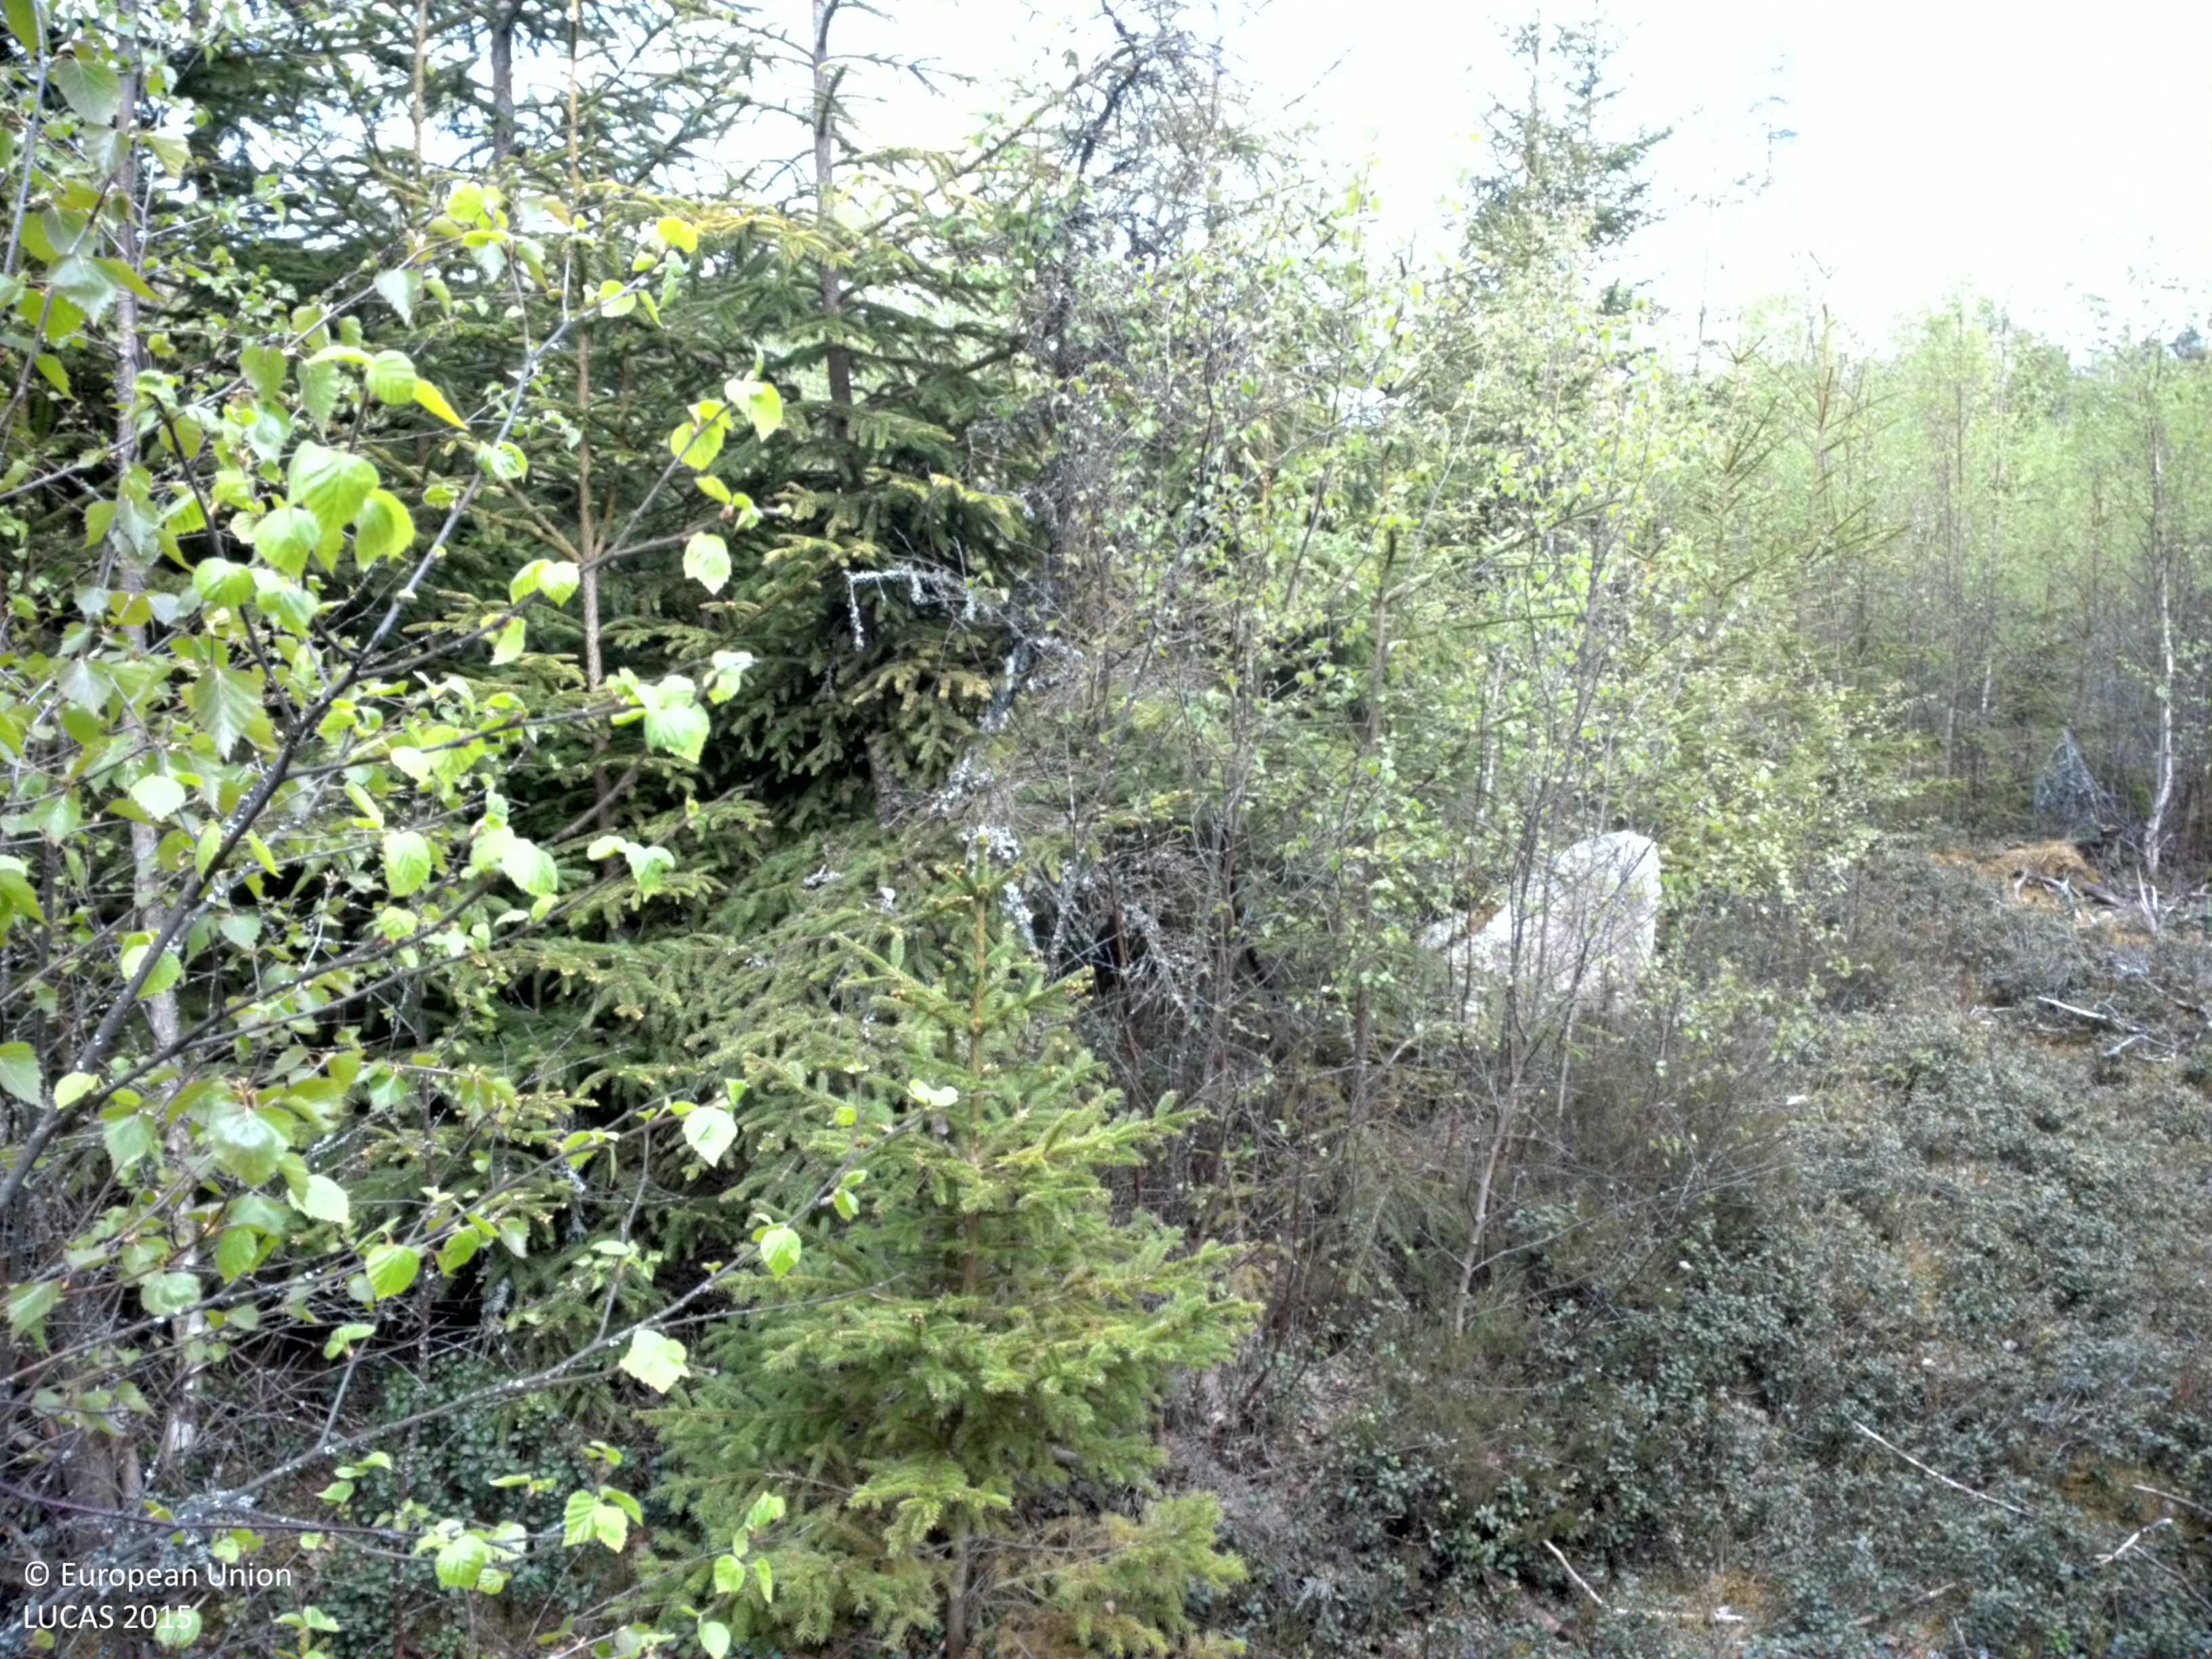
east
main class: Woodland
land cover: Broadleaved woodland
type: boreal forest
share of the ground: 50 - 75 %
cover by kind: broadleaved forest trees 55 %, shrubs 15 %, coniferous forest trees 10 %, herbaceous plants 10 %, lichens and mosses 10 %
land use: Forestry
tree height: < 5 m
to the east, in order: Broadleaved woodland
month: May
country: SE
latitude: 56.7599
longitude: 15.3798
